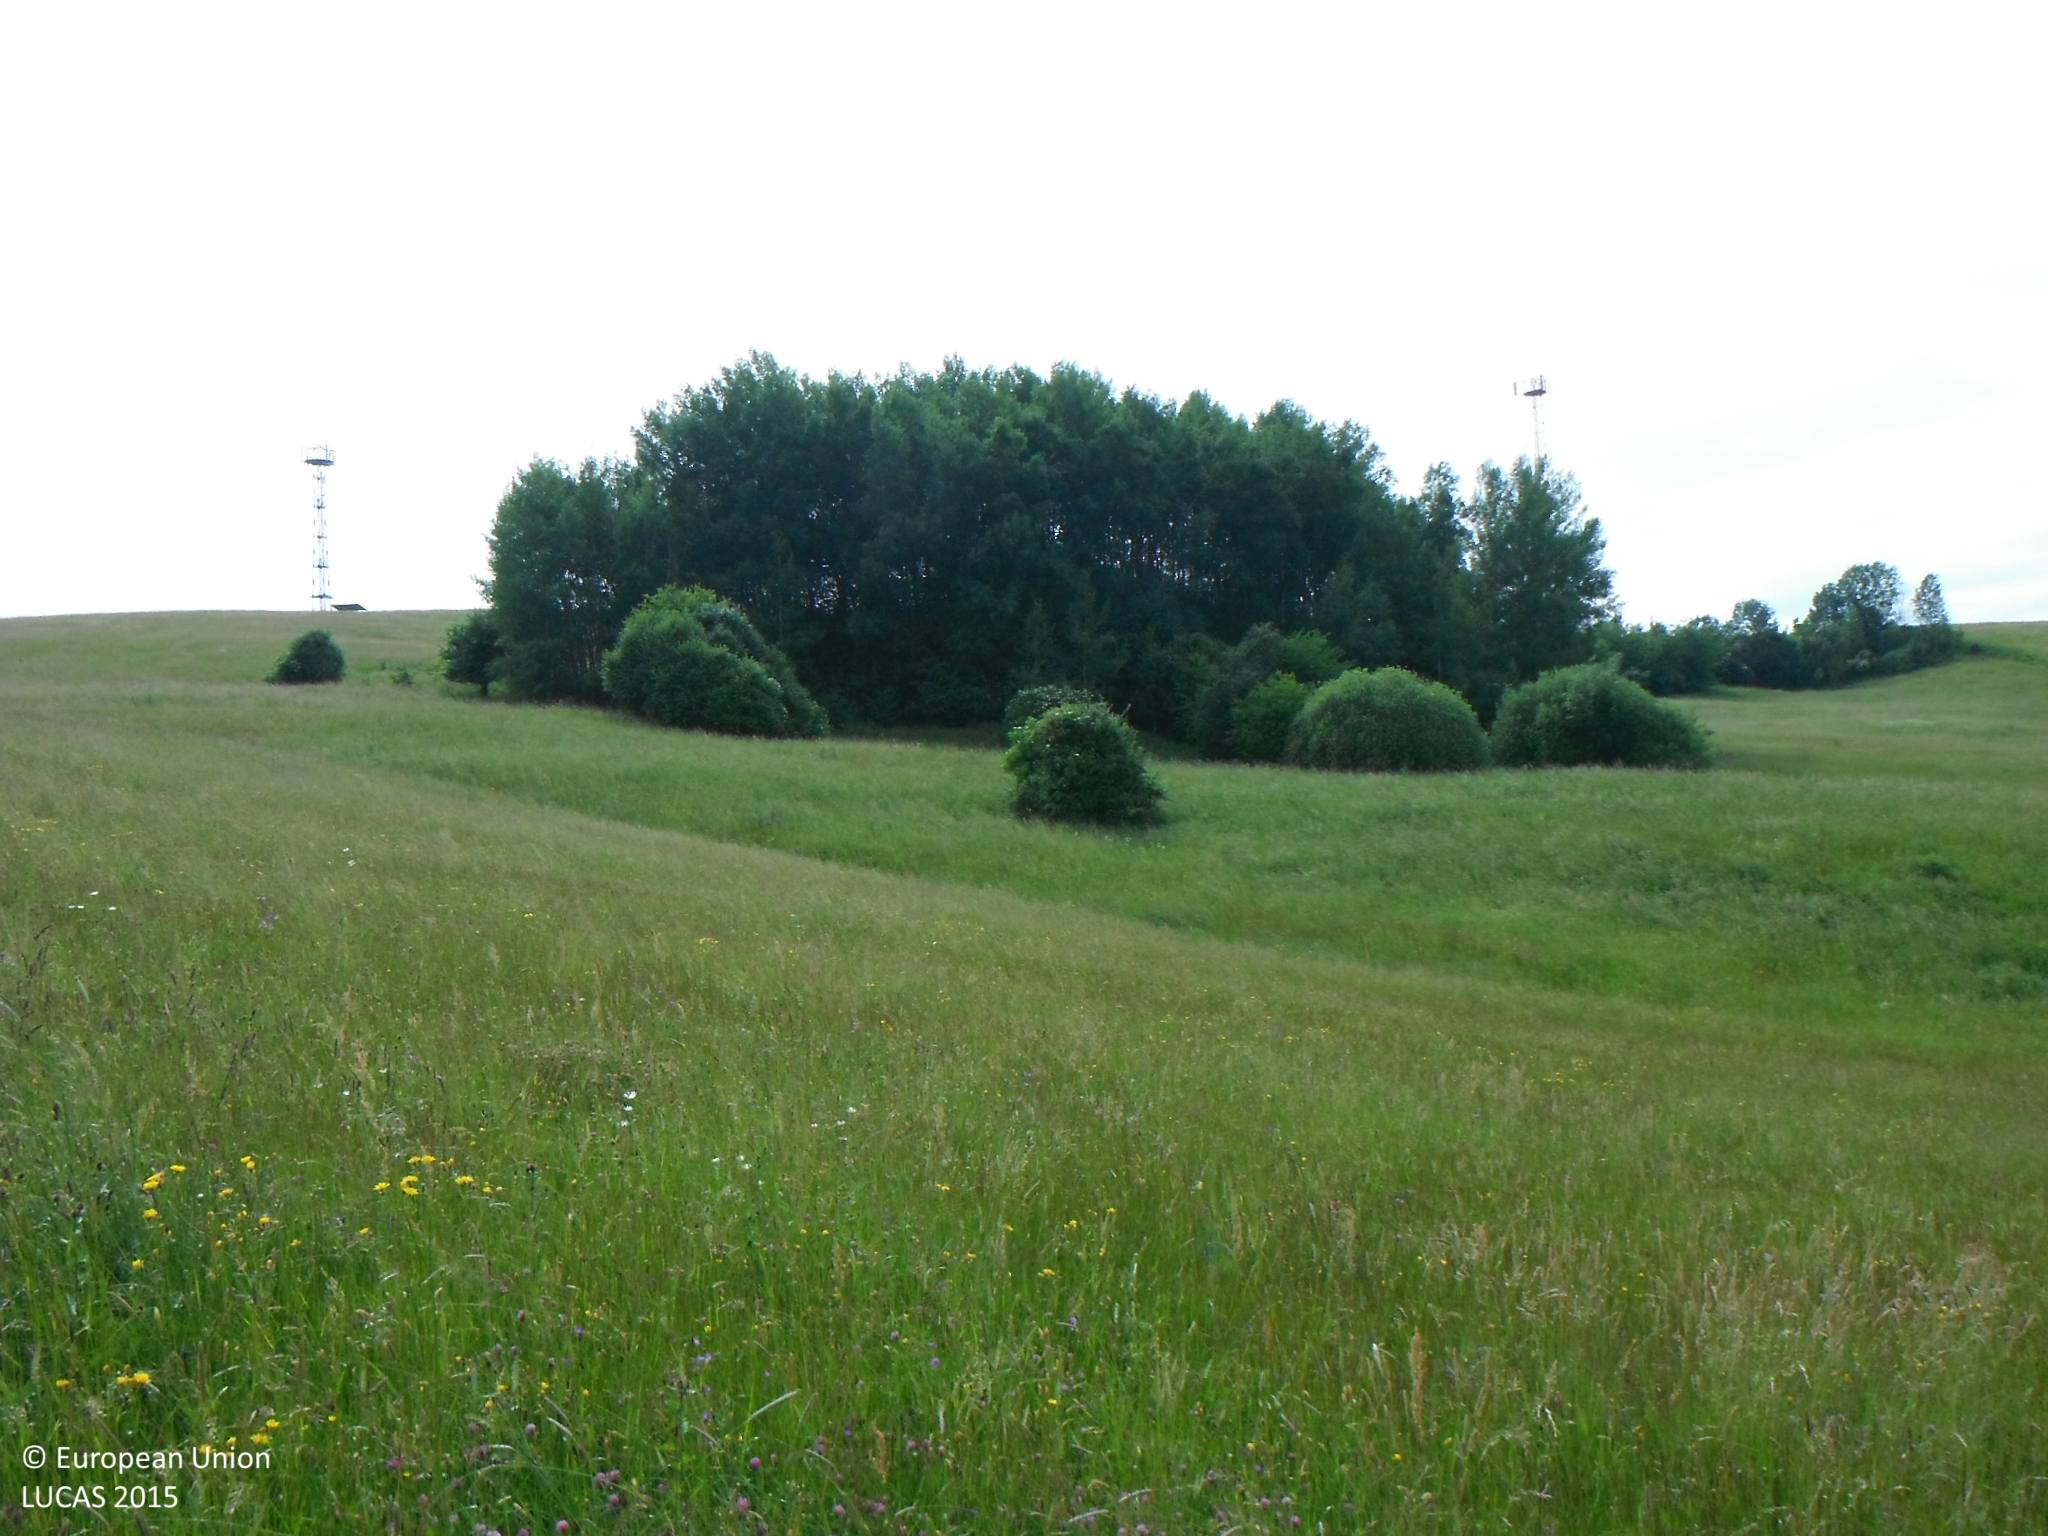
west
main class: Grassland
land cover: Grassland without tree/shrub cover
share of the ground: > 75 %
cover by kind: herbaceous plants 100 %
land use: Agriculture (excluding fallow land and kitchen gardens)
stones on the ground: < 10 %
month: June
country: SK
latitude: 49.0661
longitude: 19.4560
